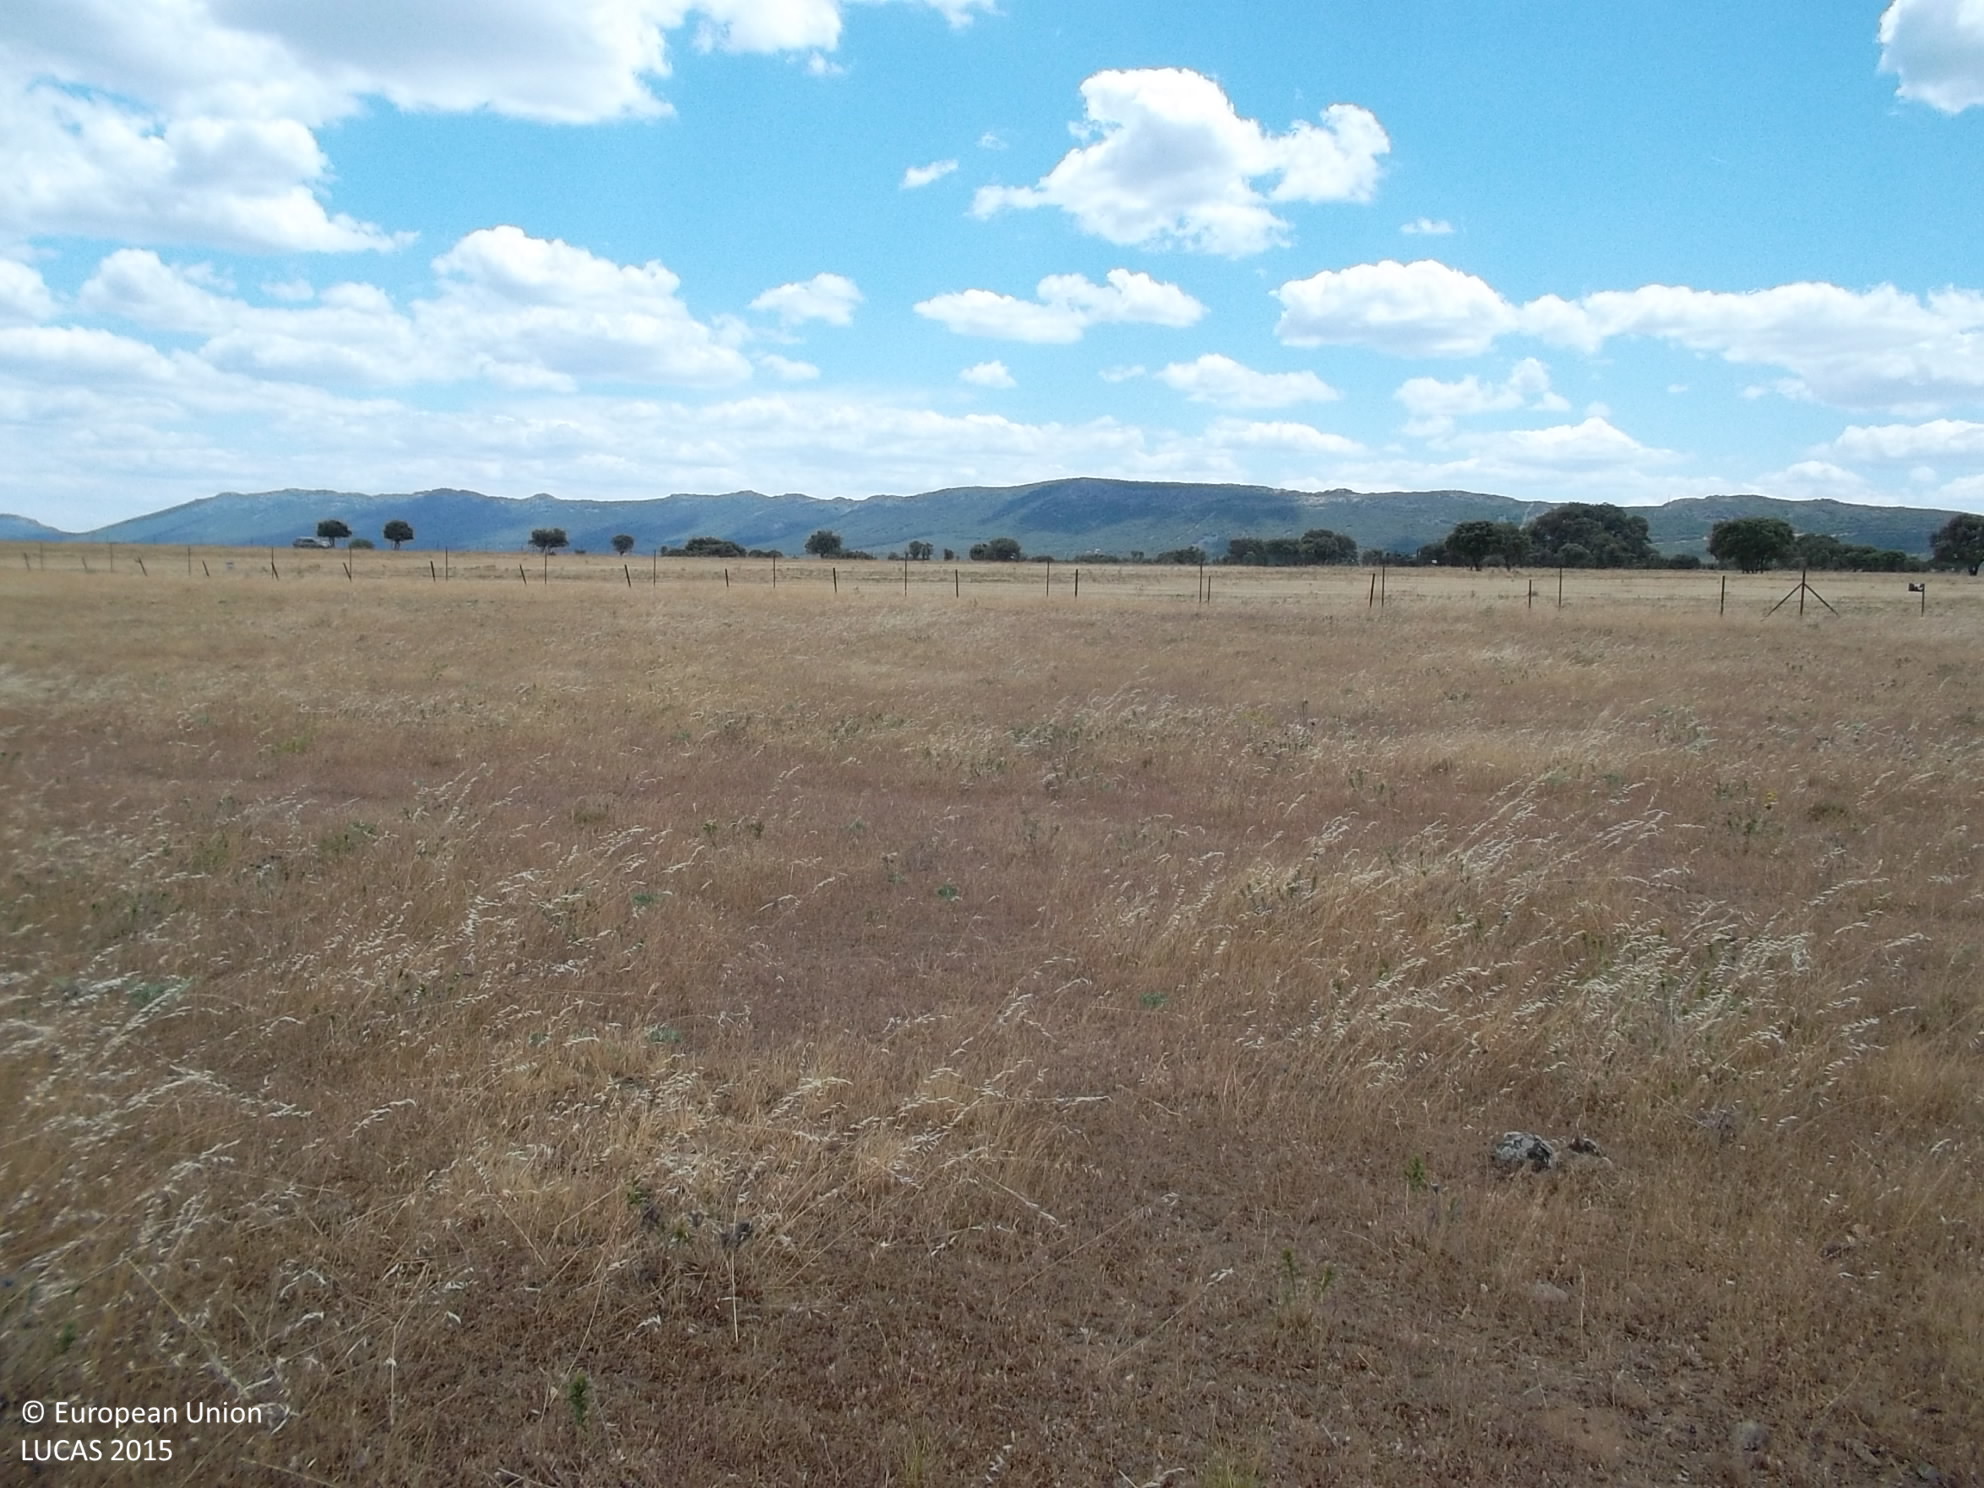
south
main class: Grassland
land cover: Grassland without tree/shrub cover
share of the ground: > 75 %
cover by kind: herbaceous plants 100 %
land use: Agriculture (excluding fallow land and kitchen gardens)
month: May
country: ES
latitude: 38.5778
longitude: -4.3801
